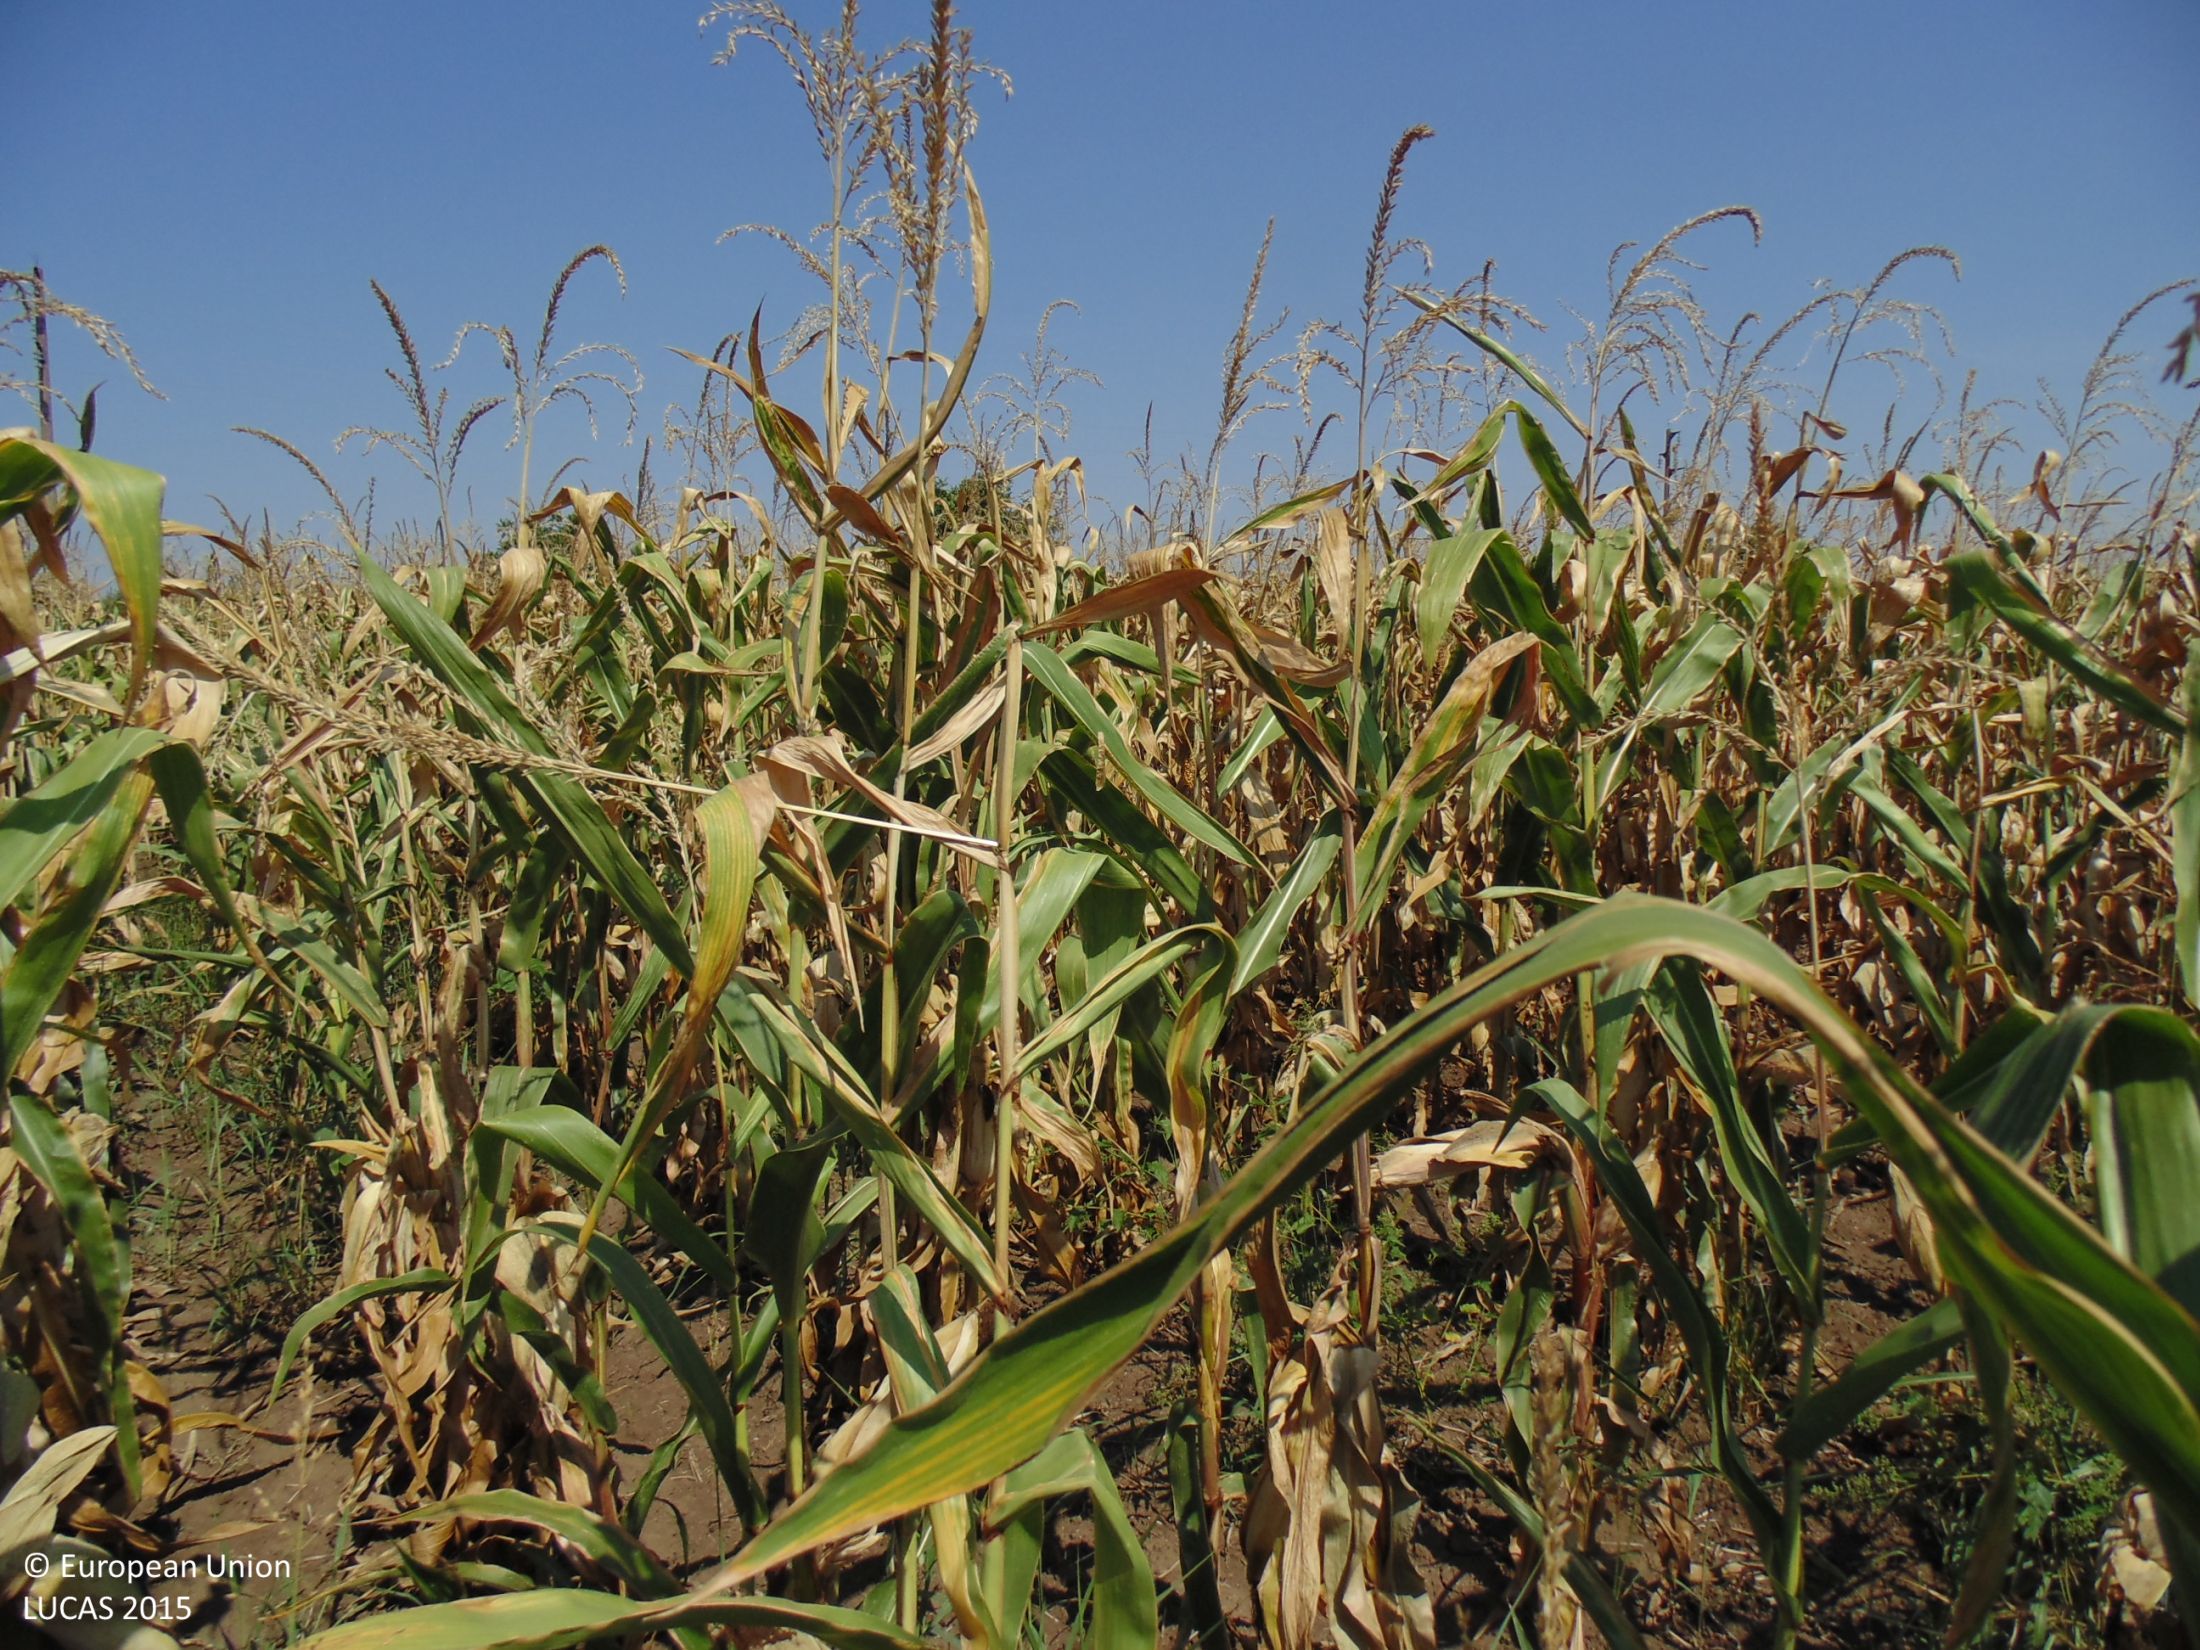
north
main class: Cropland
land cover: Maize
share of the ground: > 75 %
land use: Agriculture (excluding fallow land and kitchen gardens)
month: August
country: BG
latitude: 43.6889
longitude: 27.4383
